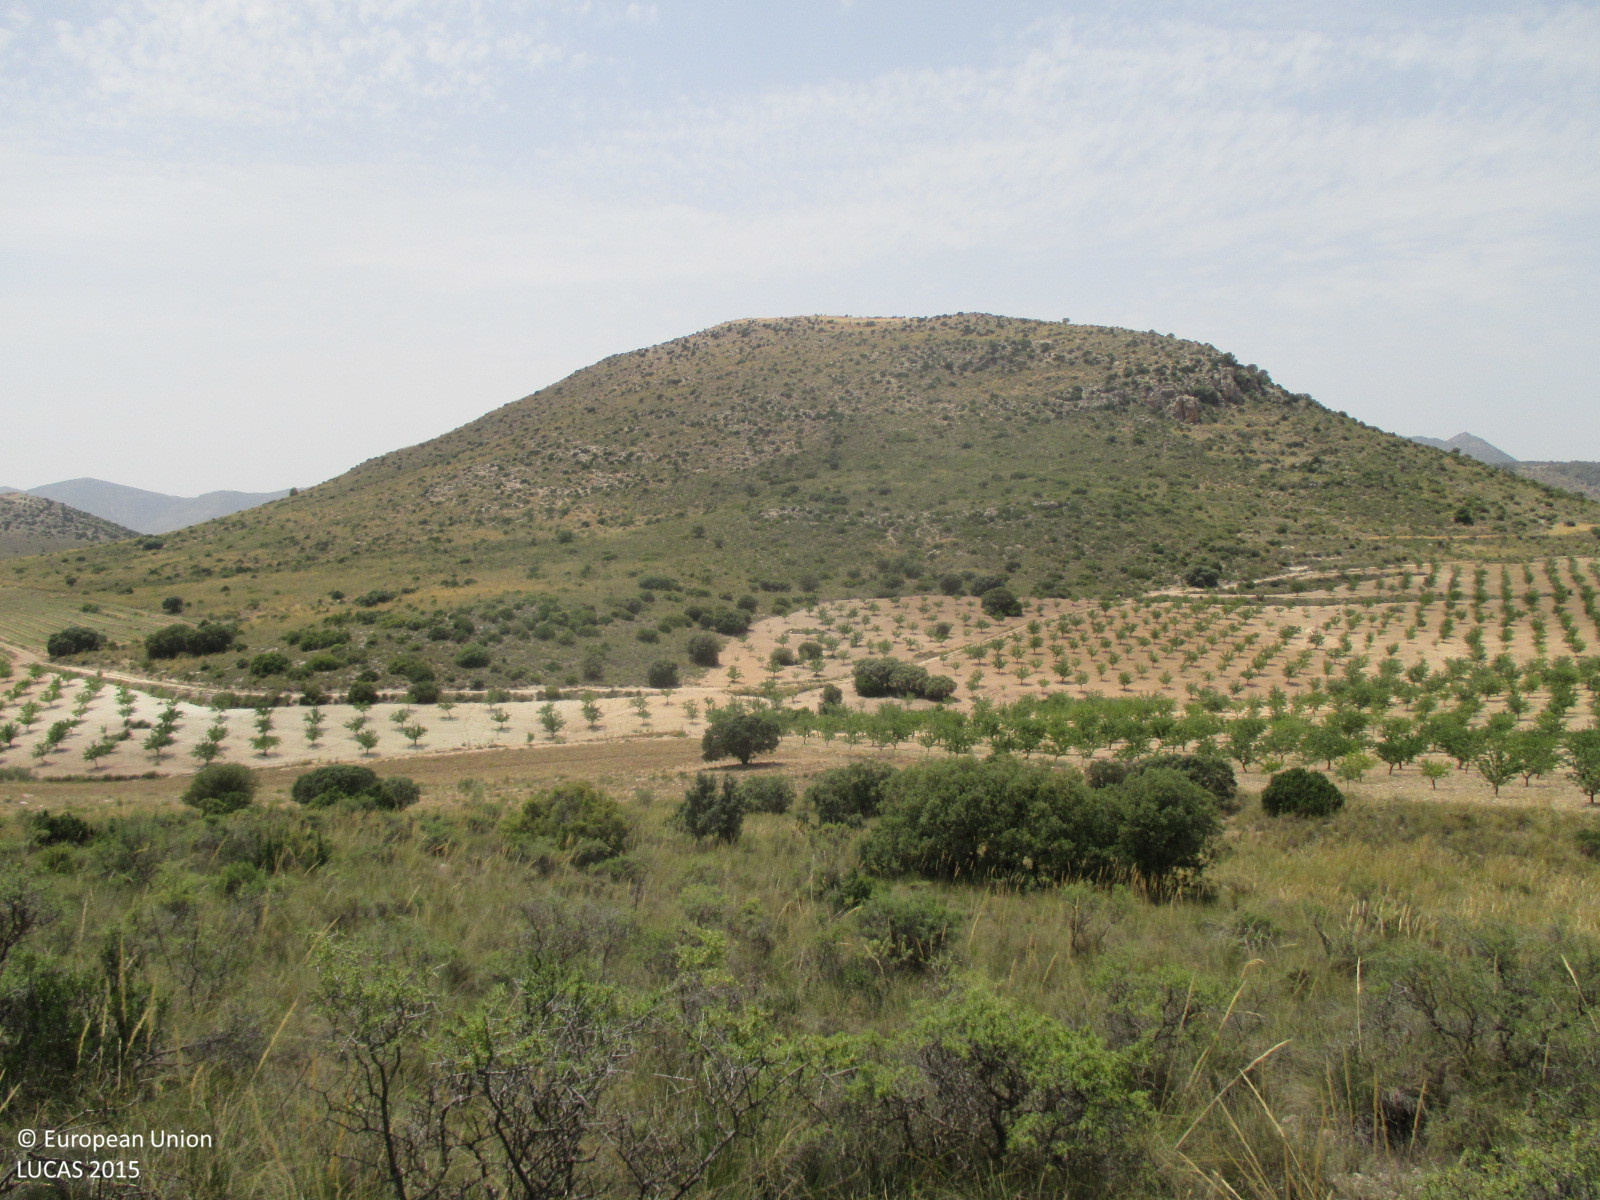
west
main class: Woodland
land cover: Broadleaved woodland
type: broadleaved evergreen forest
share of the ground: 50 - 75 %
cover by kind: broadleaved forest trees 50 %, herbaceous plants 40 %, shrubs 10 %
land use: Semi-natural and natural areas not in use
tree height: < 5 m
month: July
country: ES
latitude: 37.9247
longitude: -2.3791
